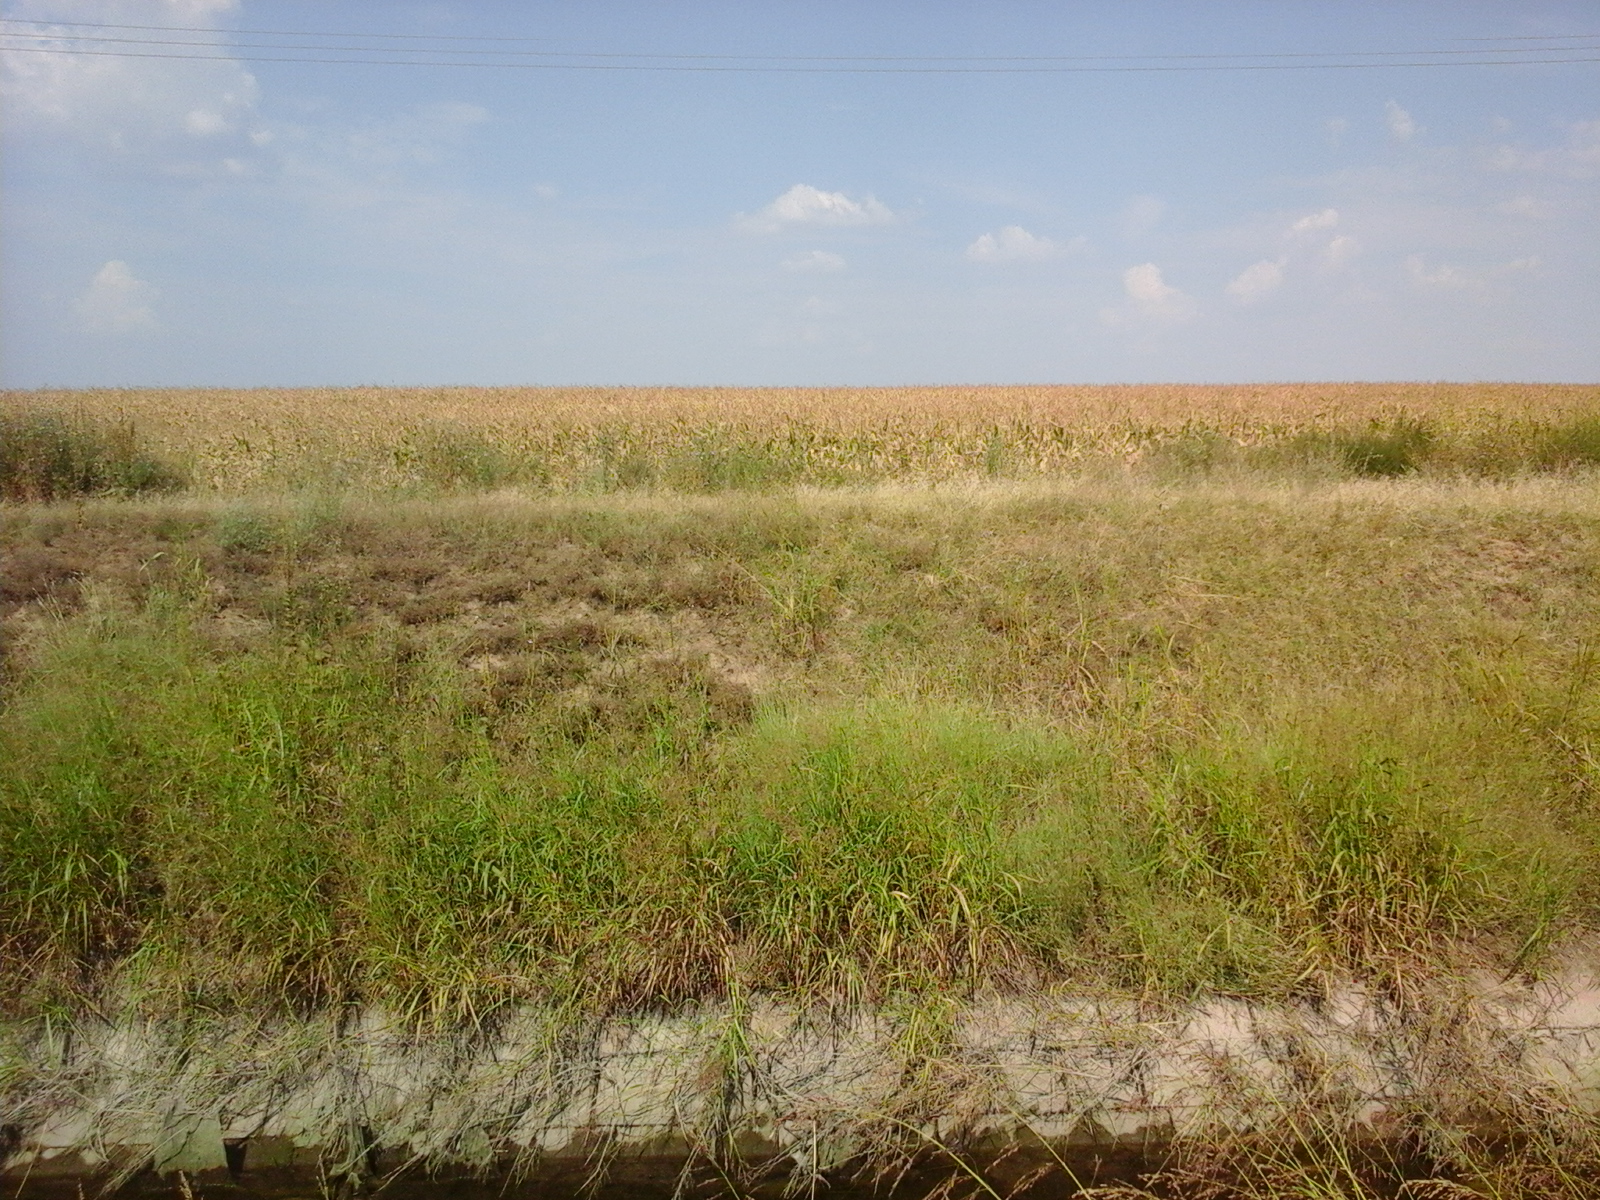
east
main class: Cropland
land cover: Maize
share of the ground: > 75 %
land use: Agriculture (excluding fallow land and kitchen gardens)
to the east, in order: Maize
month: August
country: RO
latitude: 43.9348
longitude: 23.6670
